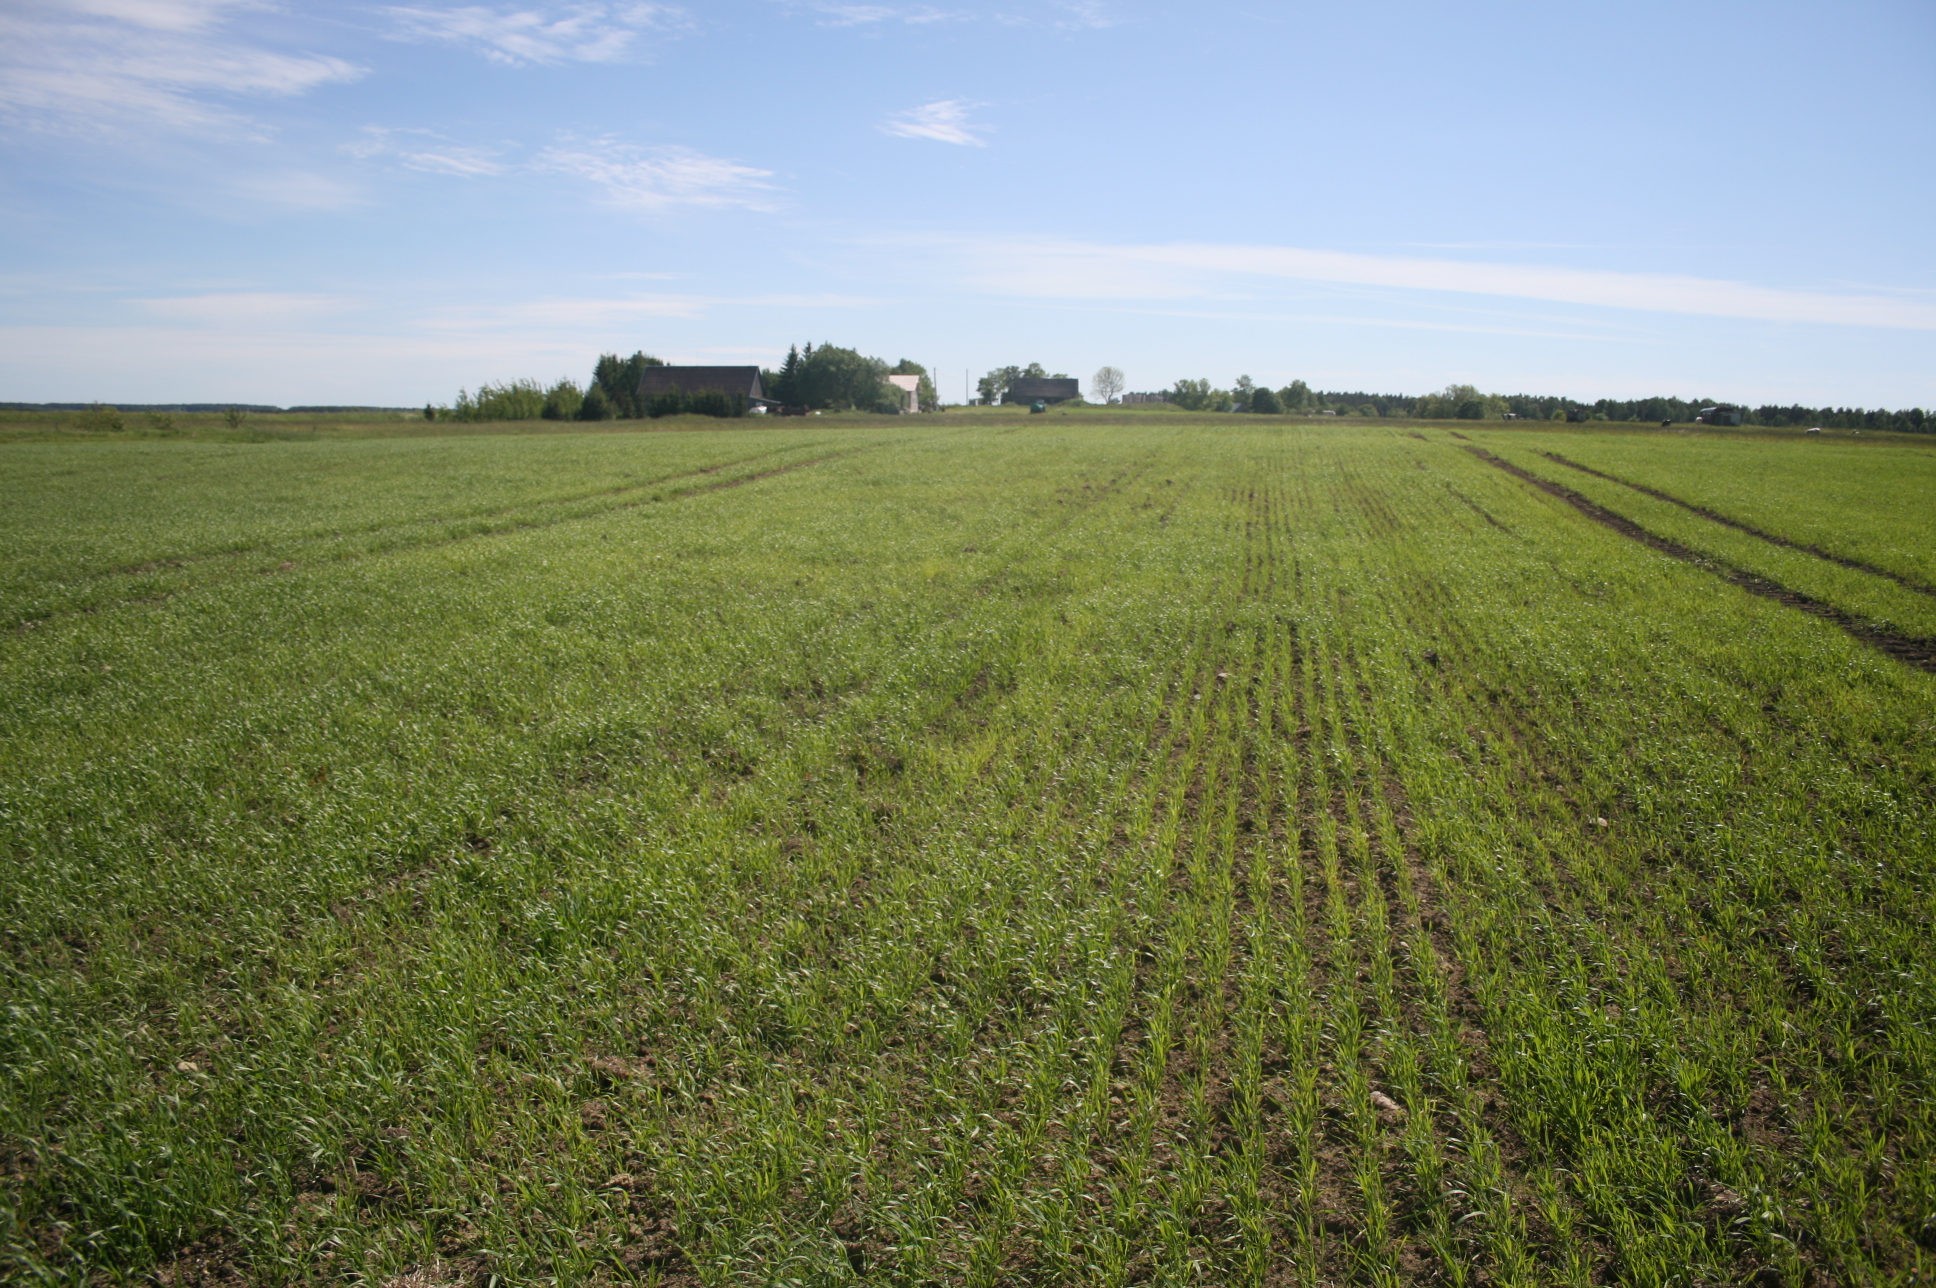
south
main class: Cropland
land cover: Common wheat
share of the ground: > 75 %
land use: Agriculture (excluding fallow land and kitchen gardens)
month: June
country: LT
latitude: 55.9451
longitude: 21.4603
